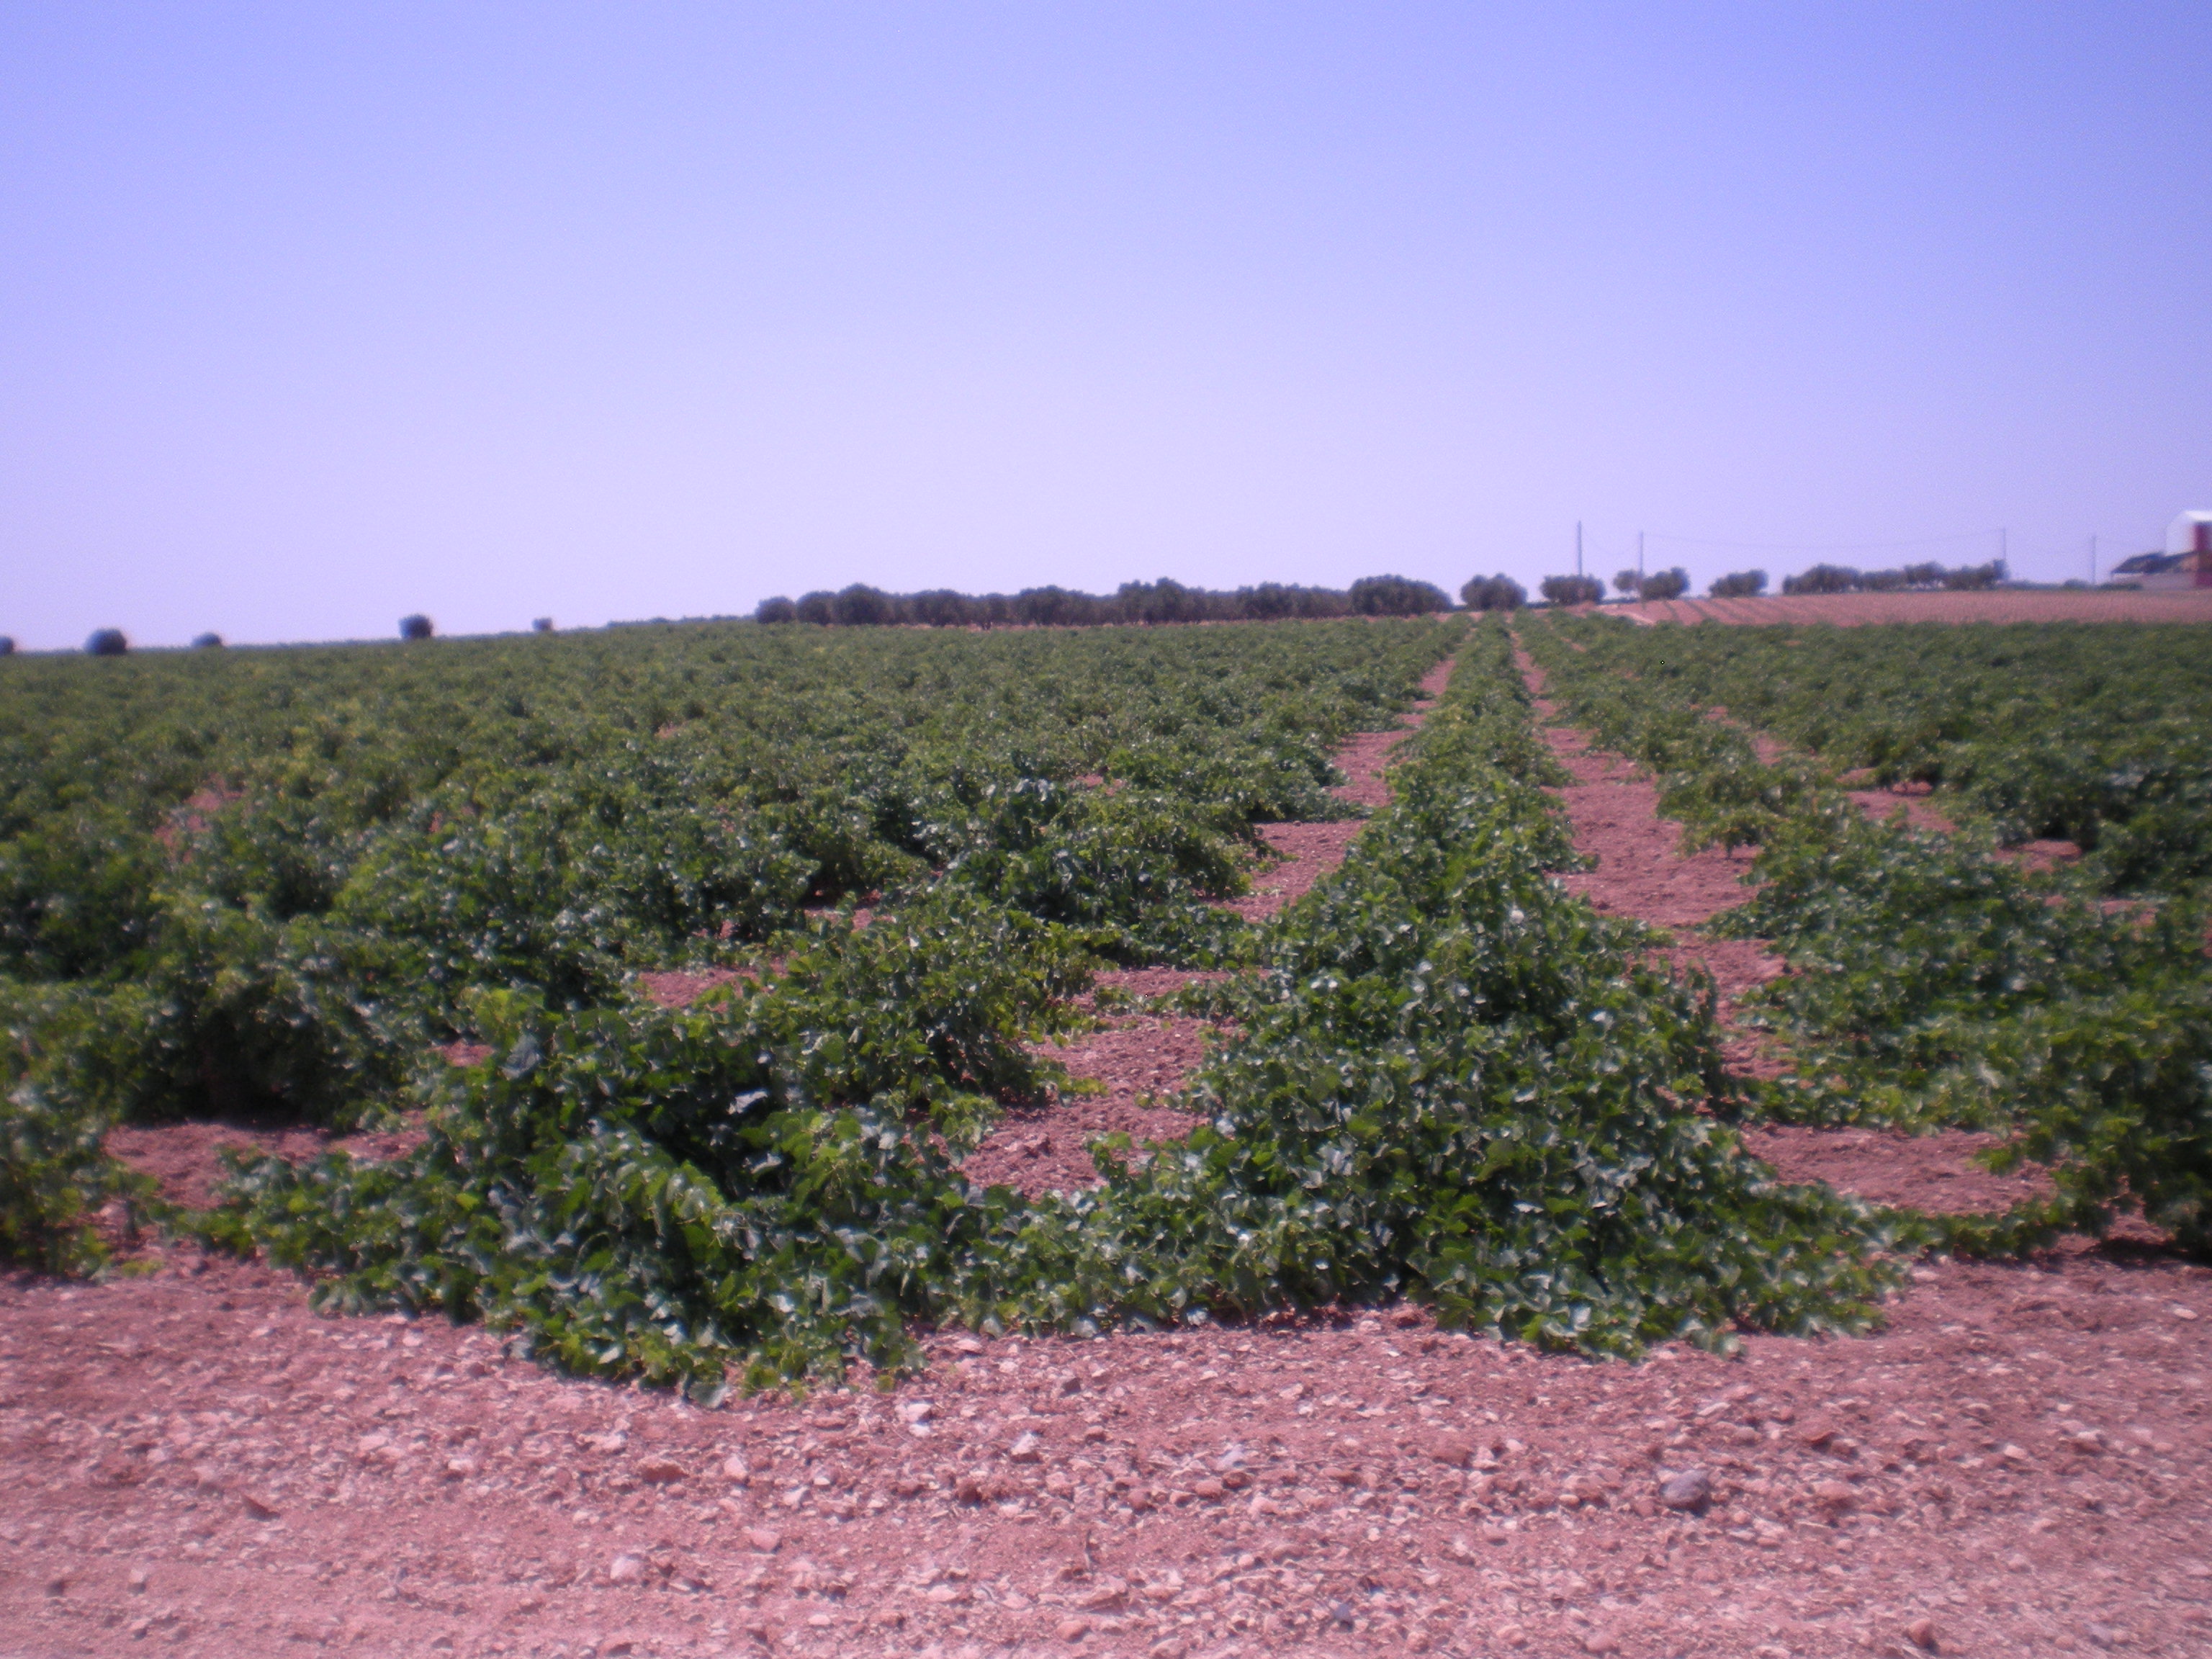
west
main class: Grassland
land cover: Grassland without tree/shrub cover
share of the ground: > 75 %
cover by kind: herbaceous plants 90 %, unconsolidated bare surface 10 %
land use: Road transport
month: July
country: ES
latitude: 39.5900
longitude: -3.0719
